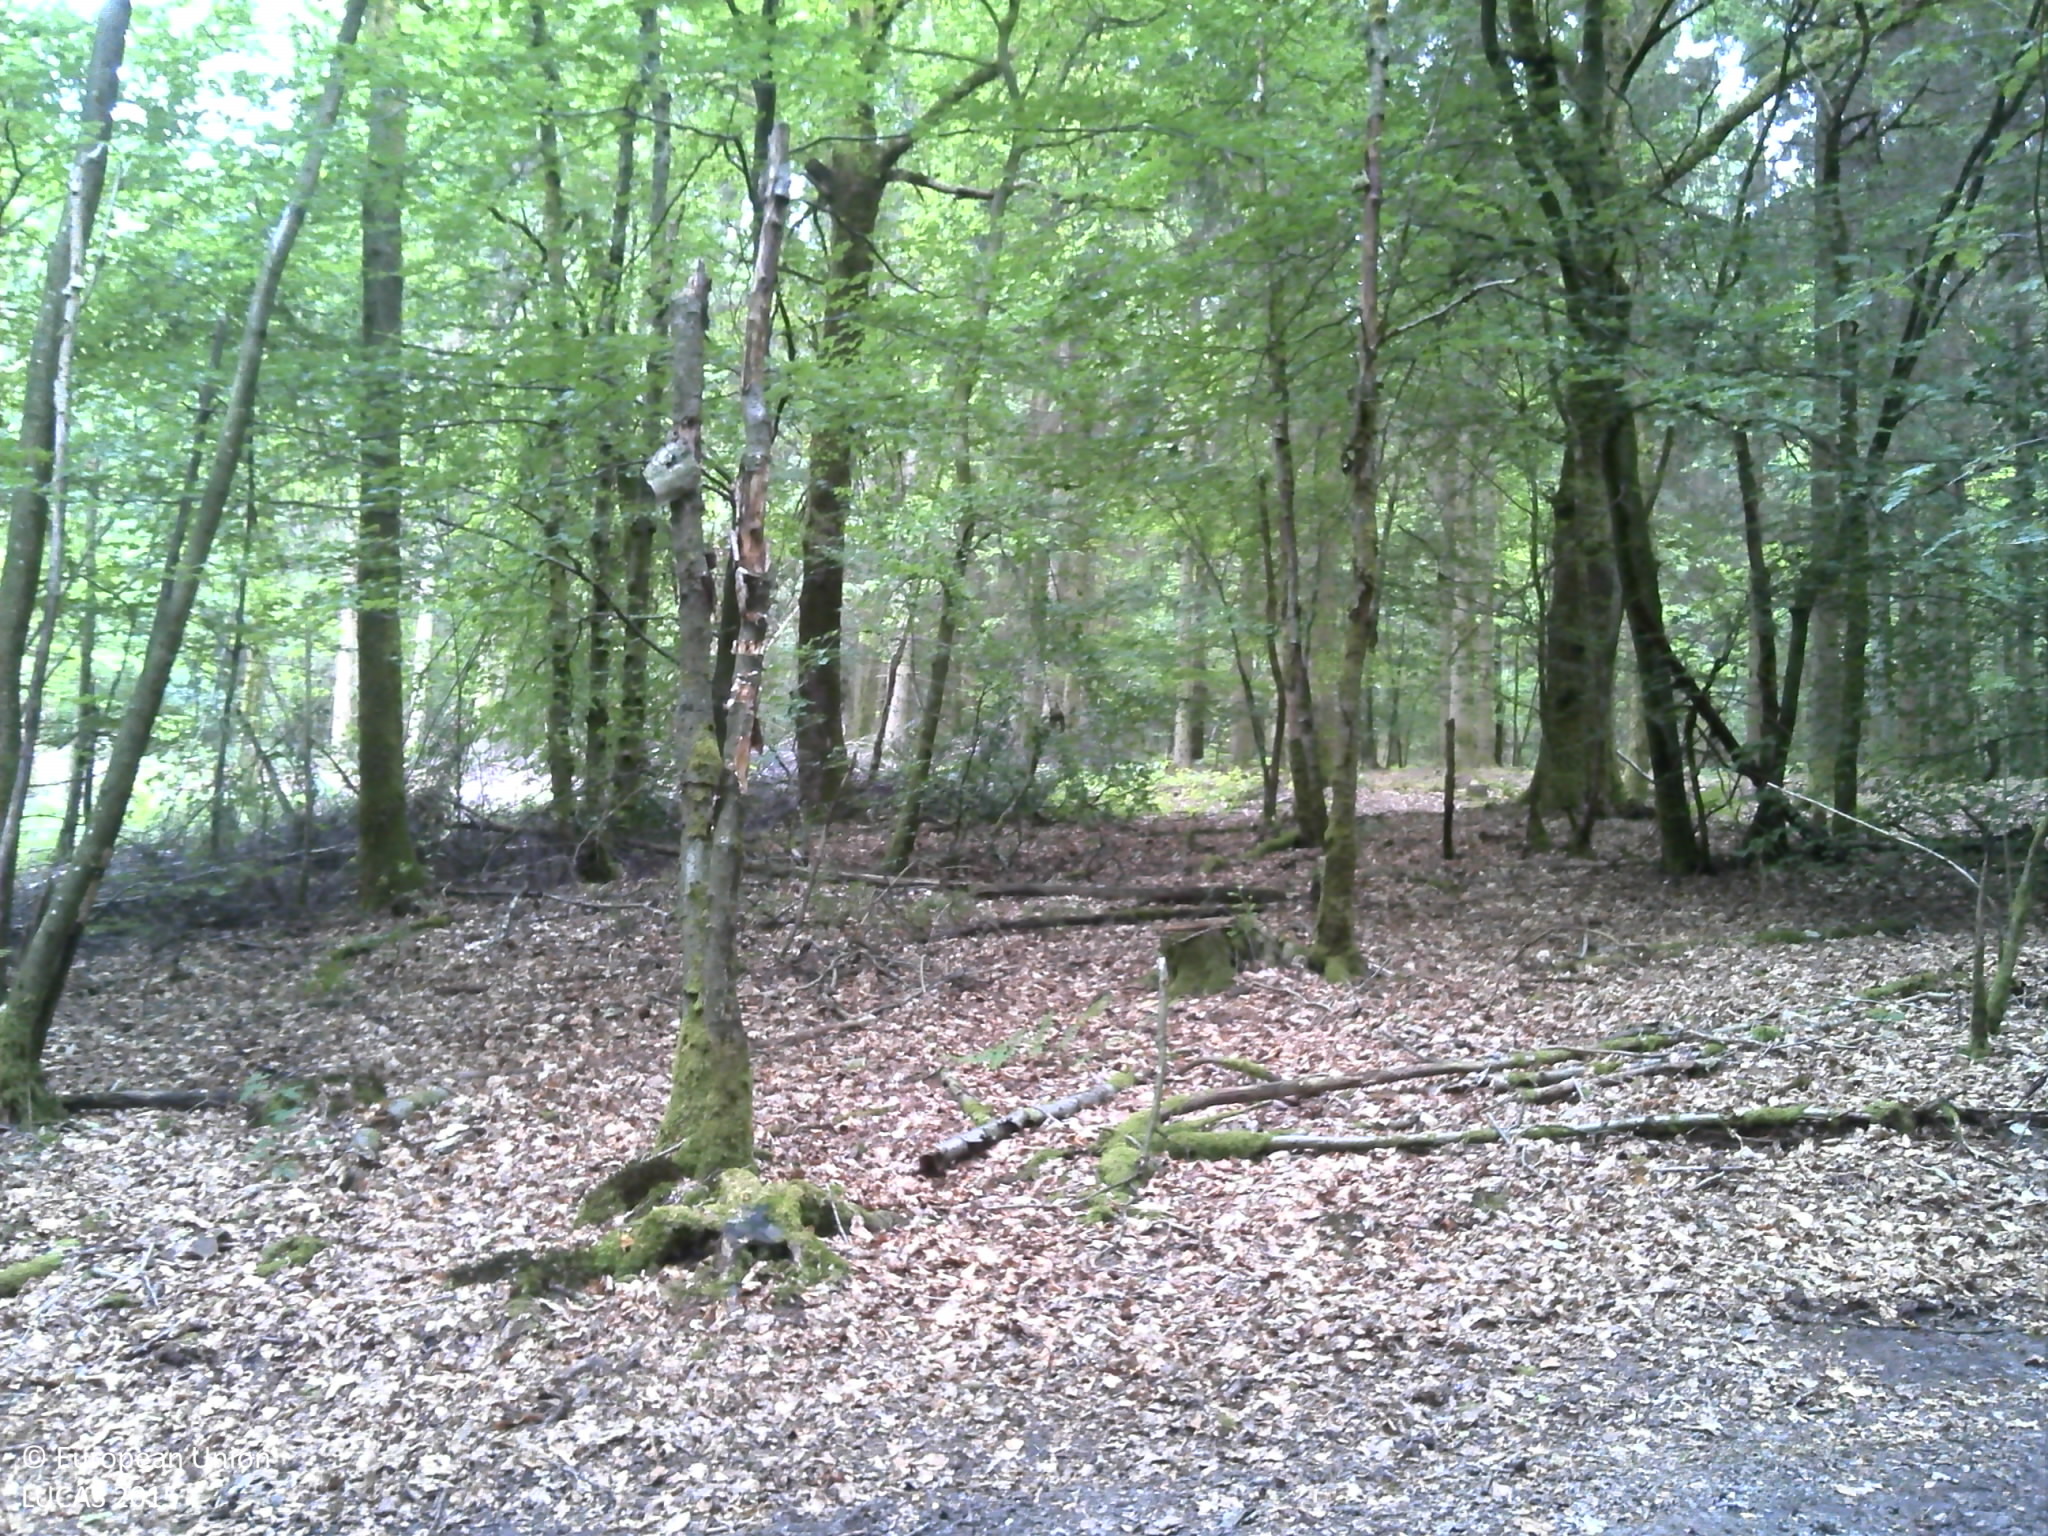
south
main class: Woodland
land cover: Broadleaved woodland
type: beech forest
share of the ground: > 75 %
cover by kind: broadleaved forest trees 70 %, consolidated bare surface 30 %
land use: Forestry
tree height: > 5 m
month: July
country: FR
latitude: 49.8268
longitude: 4.7003
